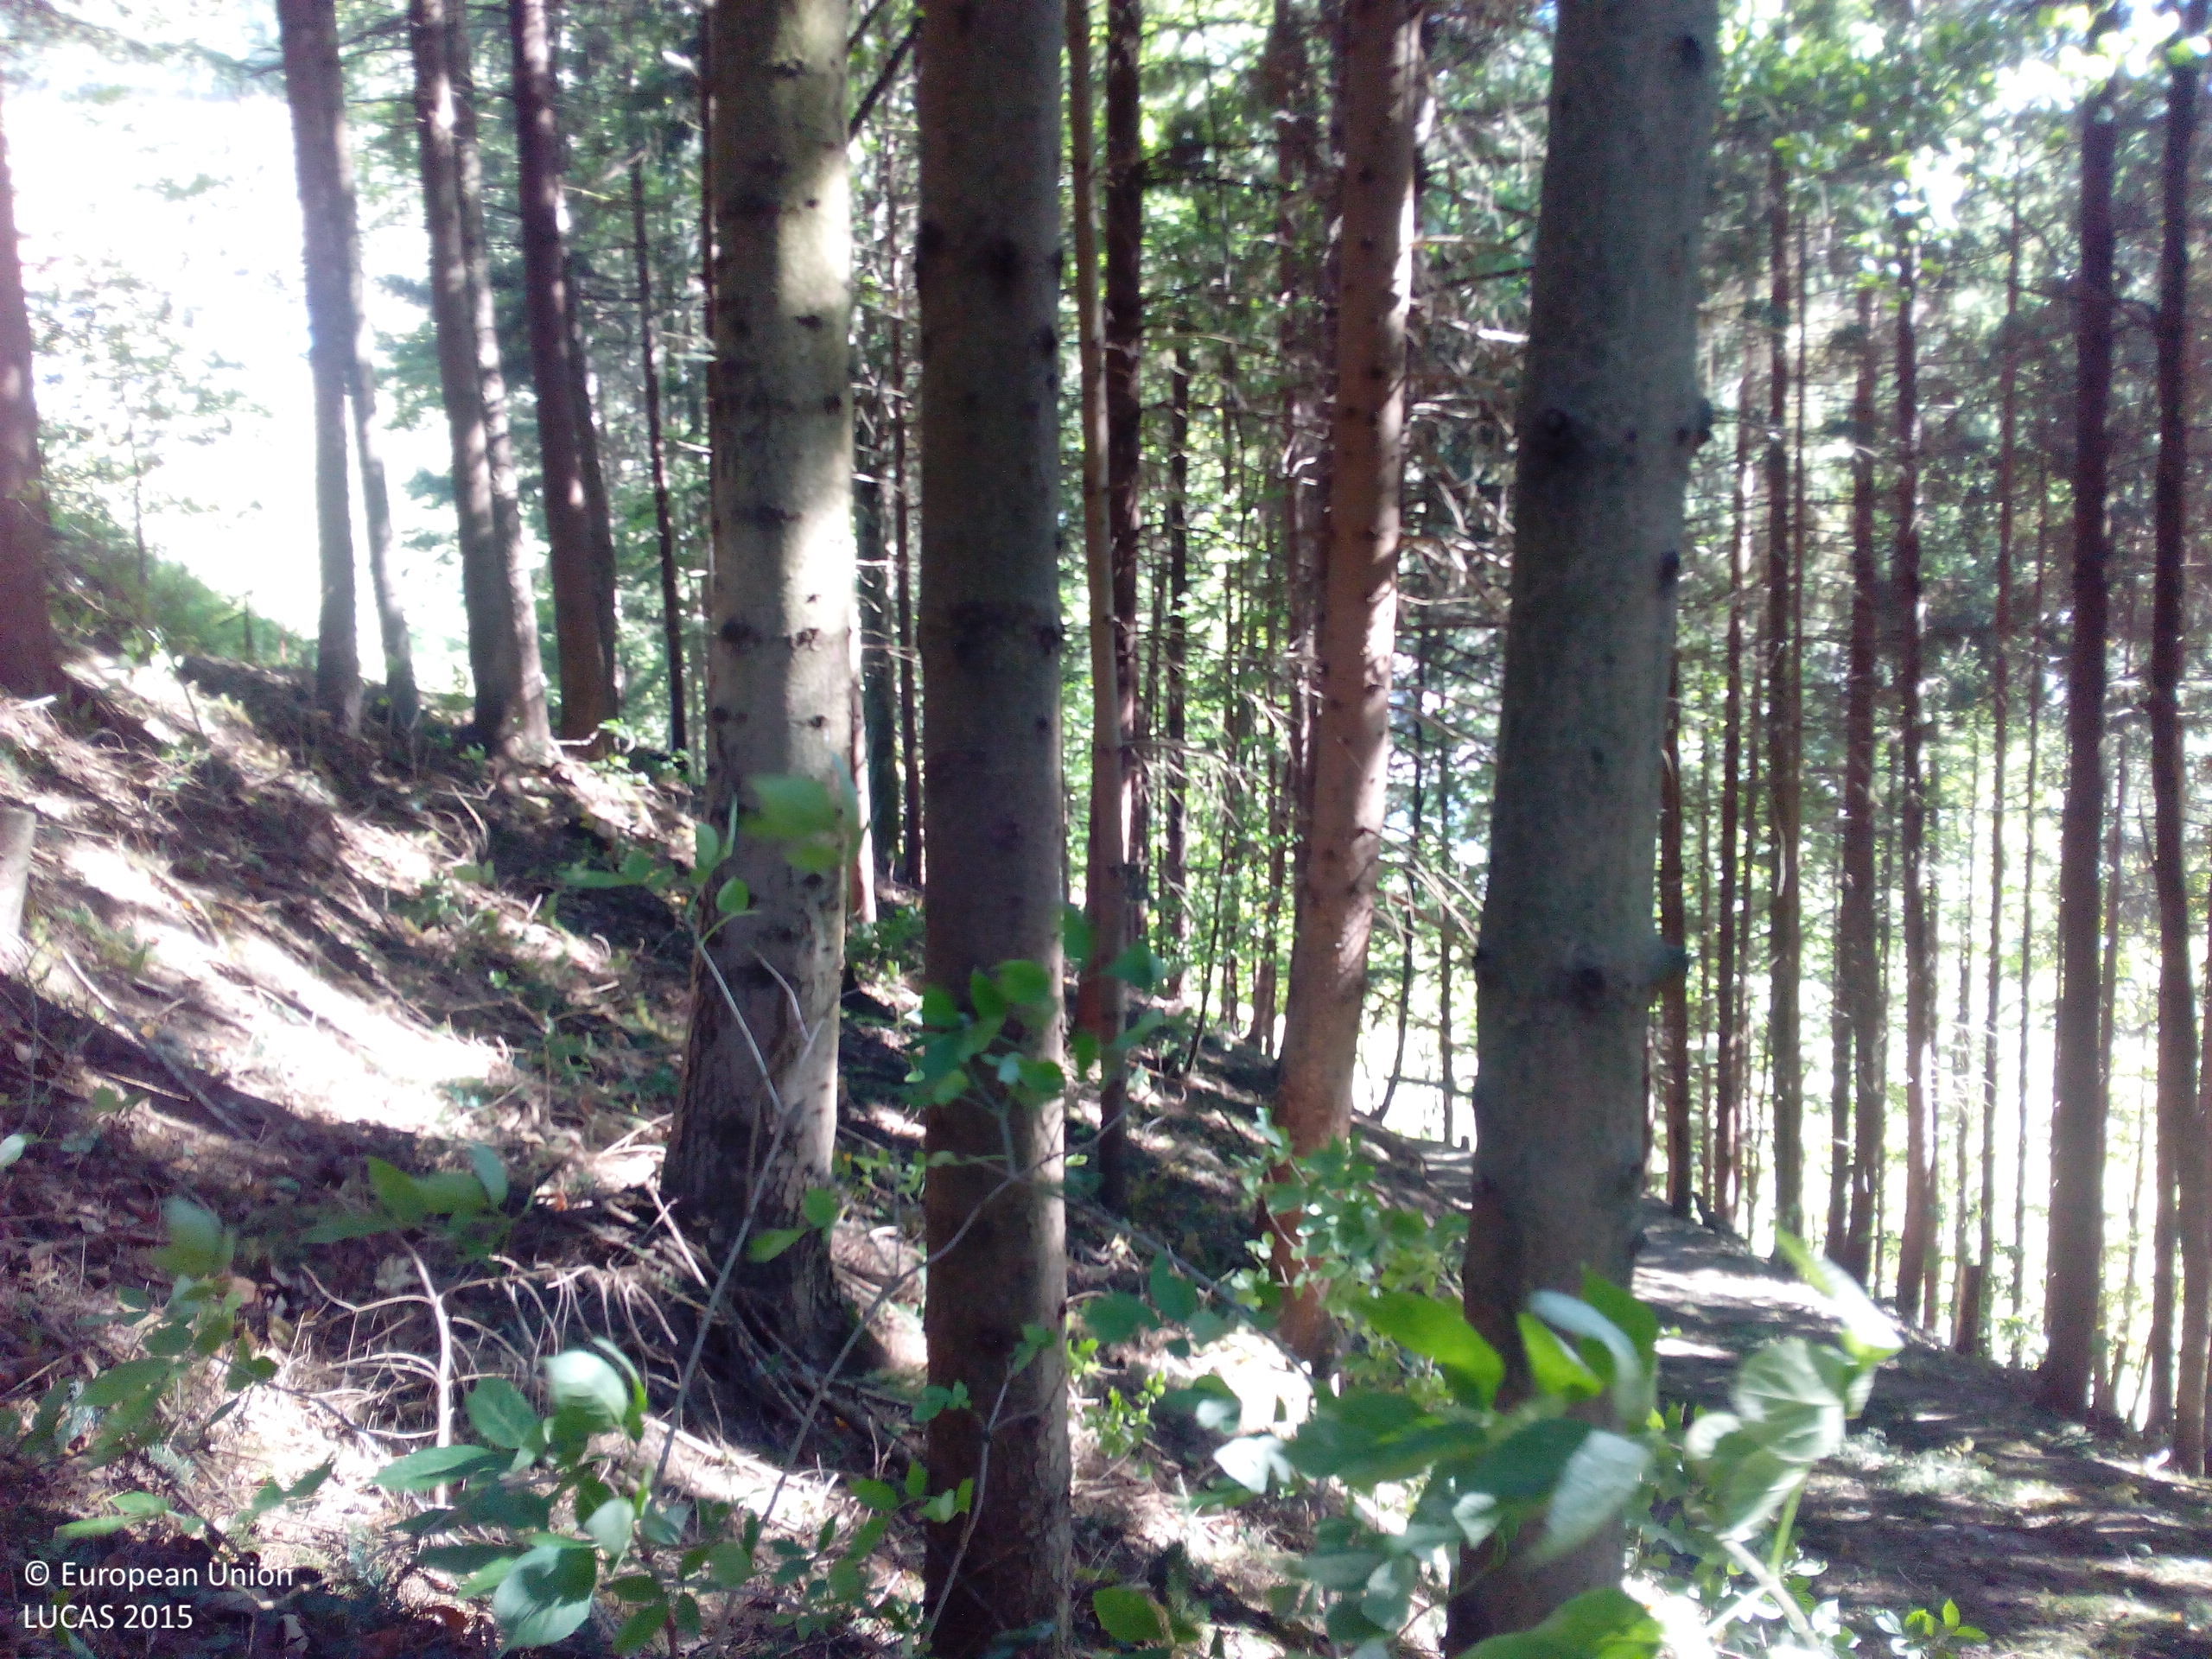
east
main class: Woodland
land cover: Spruce dominated coniferous woodland
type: hemiboreal forest and nemoral coniferous forest and mixed broadleaved-coniferous forest
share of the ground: > 75 %
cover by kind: coniferous forest trees 95 %, shrubs 5 %
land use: Forestry
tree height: > 5 m
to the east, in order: Spruce dominated coniferous woodland; Tracks; Spruce dominated coniferous woodland; Fences; Broadleaved woodland; Grassland without tree/shrub cover; Fences; Grass margins; Tracks; Grassland without tree/shrub cover; Artificial constructions in urban areas; Grassland without tree/shrub cover; Grassland with sparse tree/shrub cover; Tracks; Grassland without tree/shrub cover; Tracks; Grassland without tree/shrub cover; Single bushes/trees; Grassland without tree/shrub cover; Broadleaved woodland; Tracks; Spruce dominated coniferous woodland; Tracks; Spruce dominated mixed woodland
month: September
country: DE
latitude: 48.5504
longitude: 8.1719
